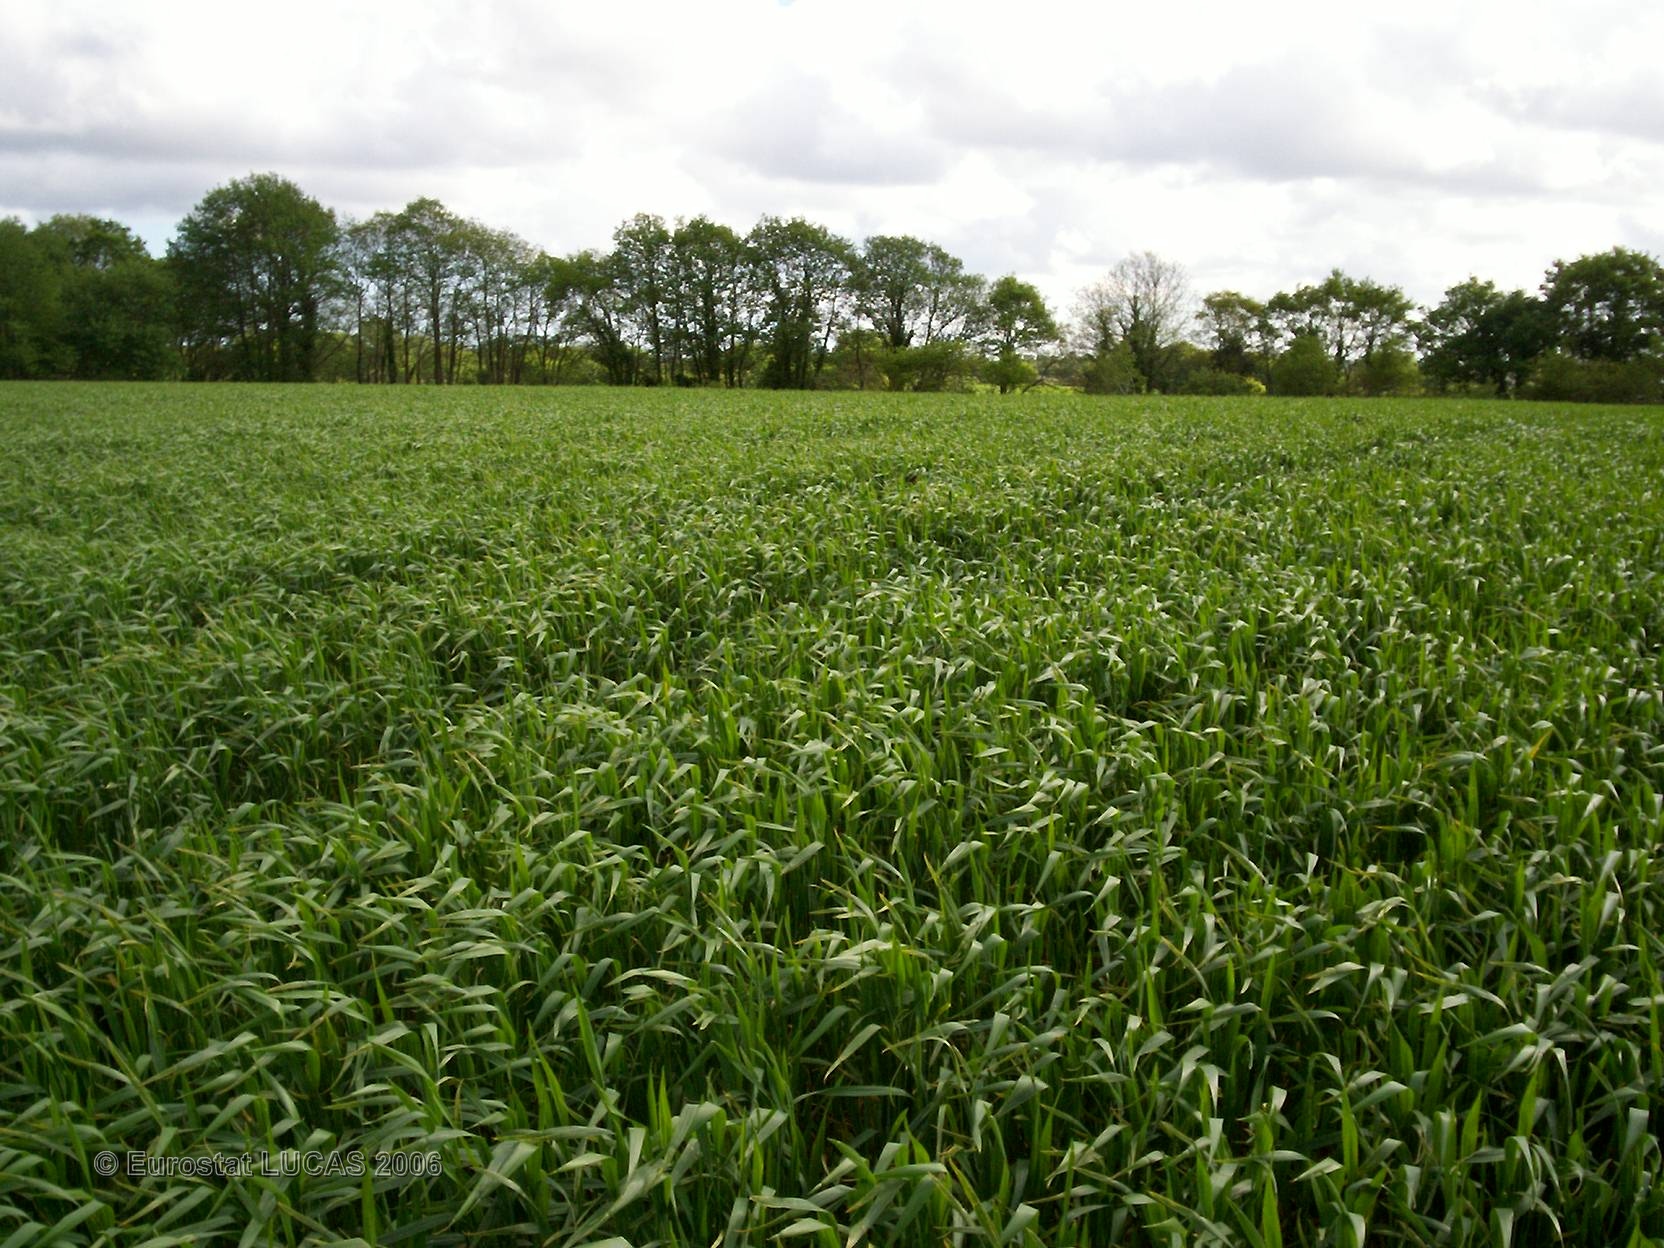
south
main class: Cropland
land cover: Common wheat
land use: Agriculture (excluding fallow land and kitchen gardens)
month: May
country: FR
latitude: 47.9981
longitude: -3.8745
